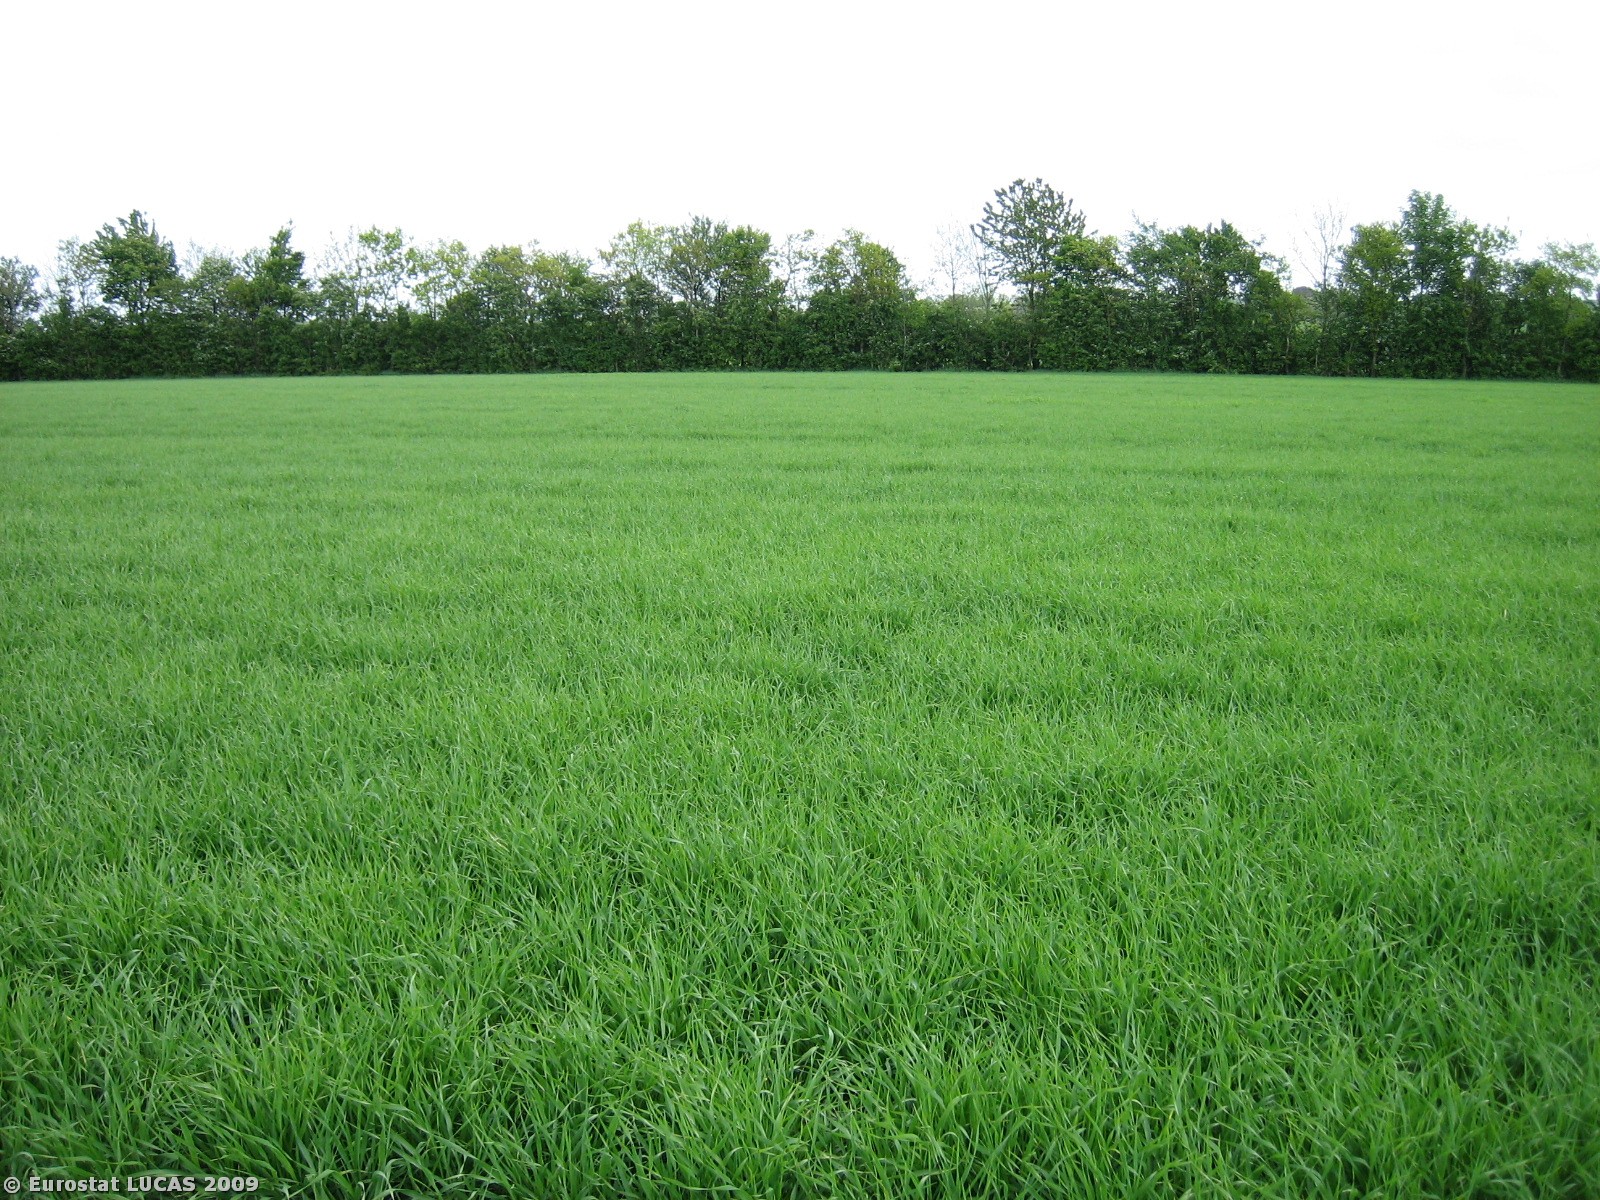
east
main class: Cropland
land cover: Barley
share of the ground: > 75 %
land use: Agriculture (excluding fallow land and kitchen gardens)
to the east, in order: Barley; Broadleaved woodland; Barley; Broadleaved woodland
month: May
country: DK
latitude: 56.1467
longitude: 8.8585
